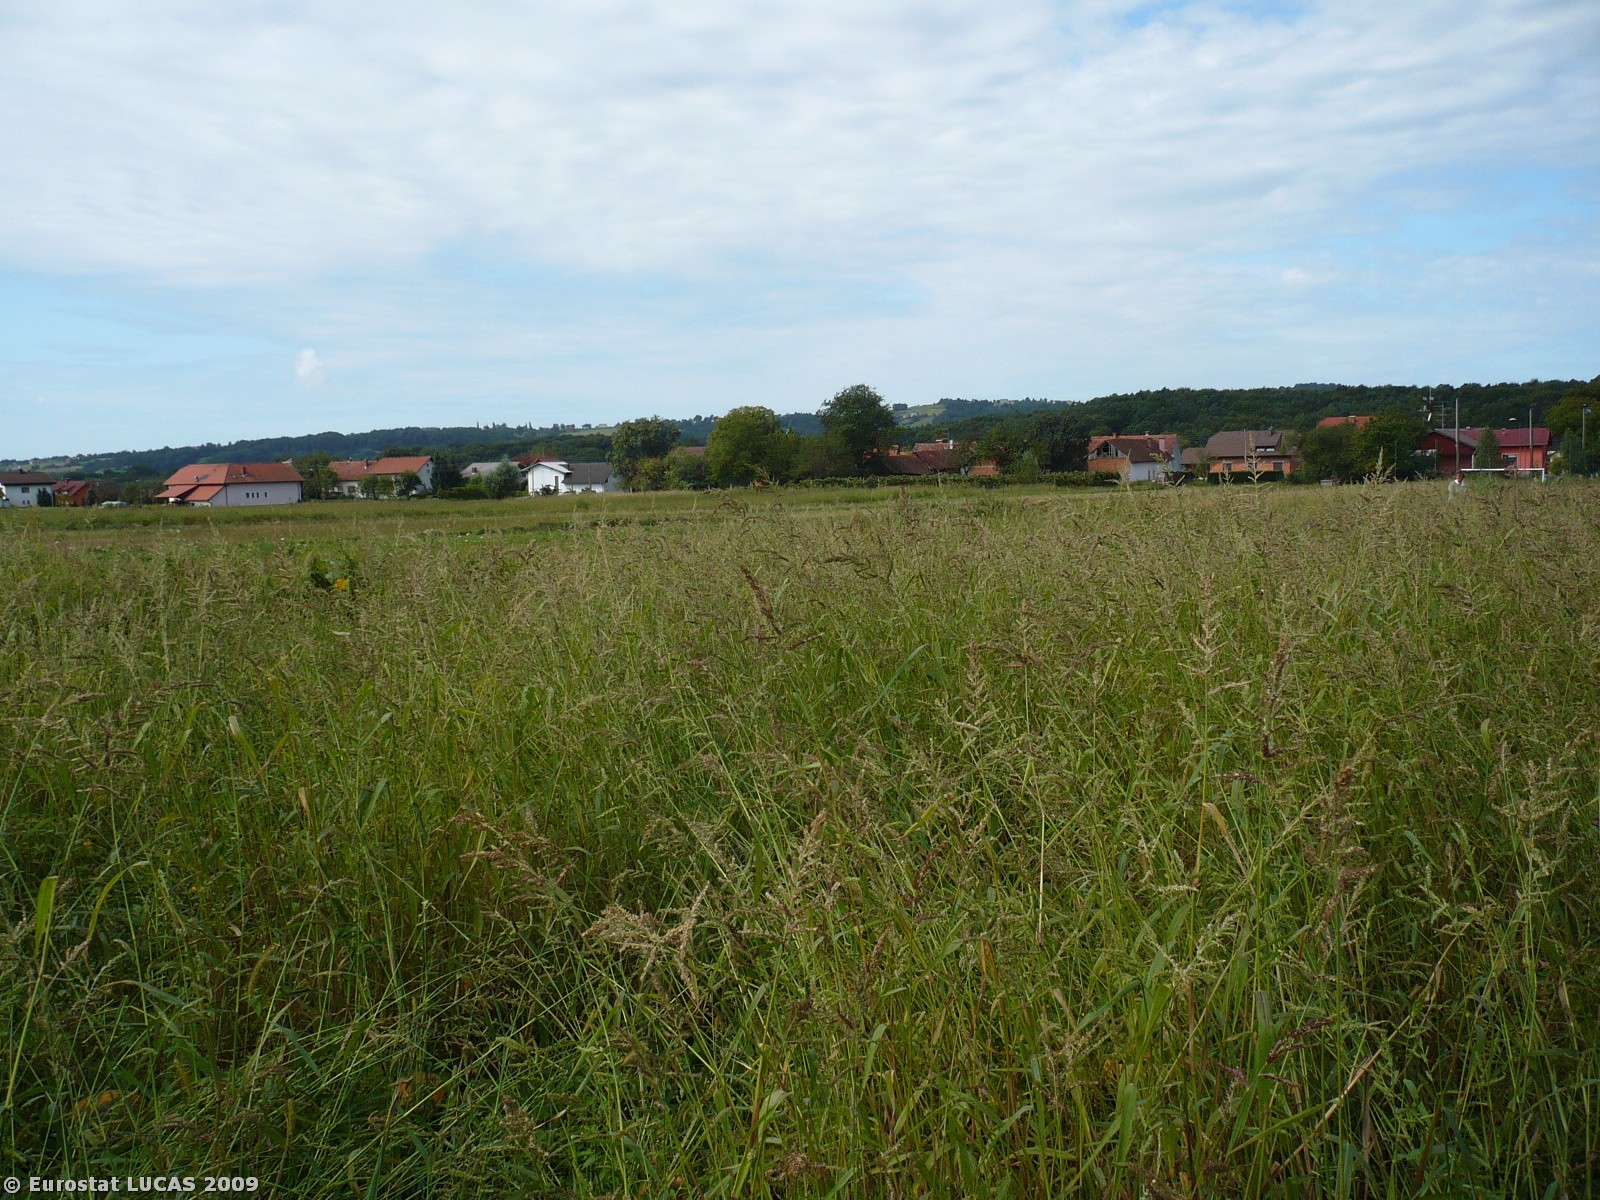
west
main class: Cropland
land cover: Other fresh vegetables
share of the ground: > 75 %
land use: Agriculture (excluding fallow land and kitchen gardens)
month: July
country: SI
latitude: 46.7751
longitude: 16.0642
